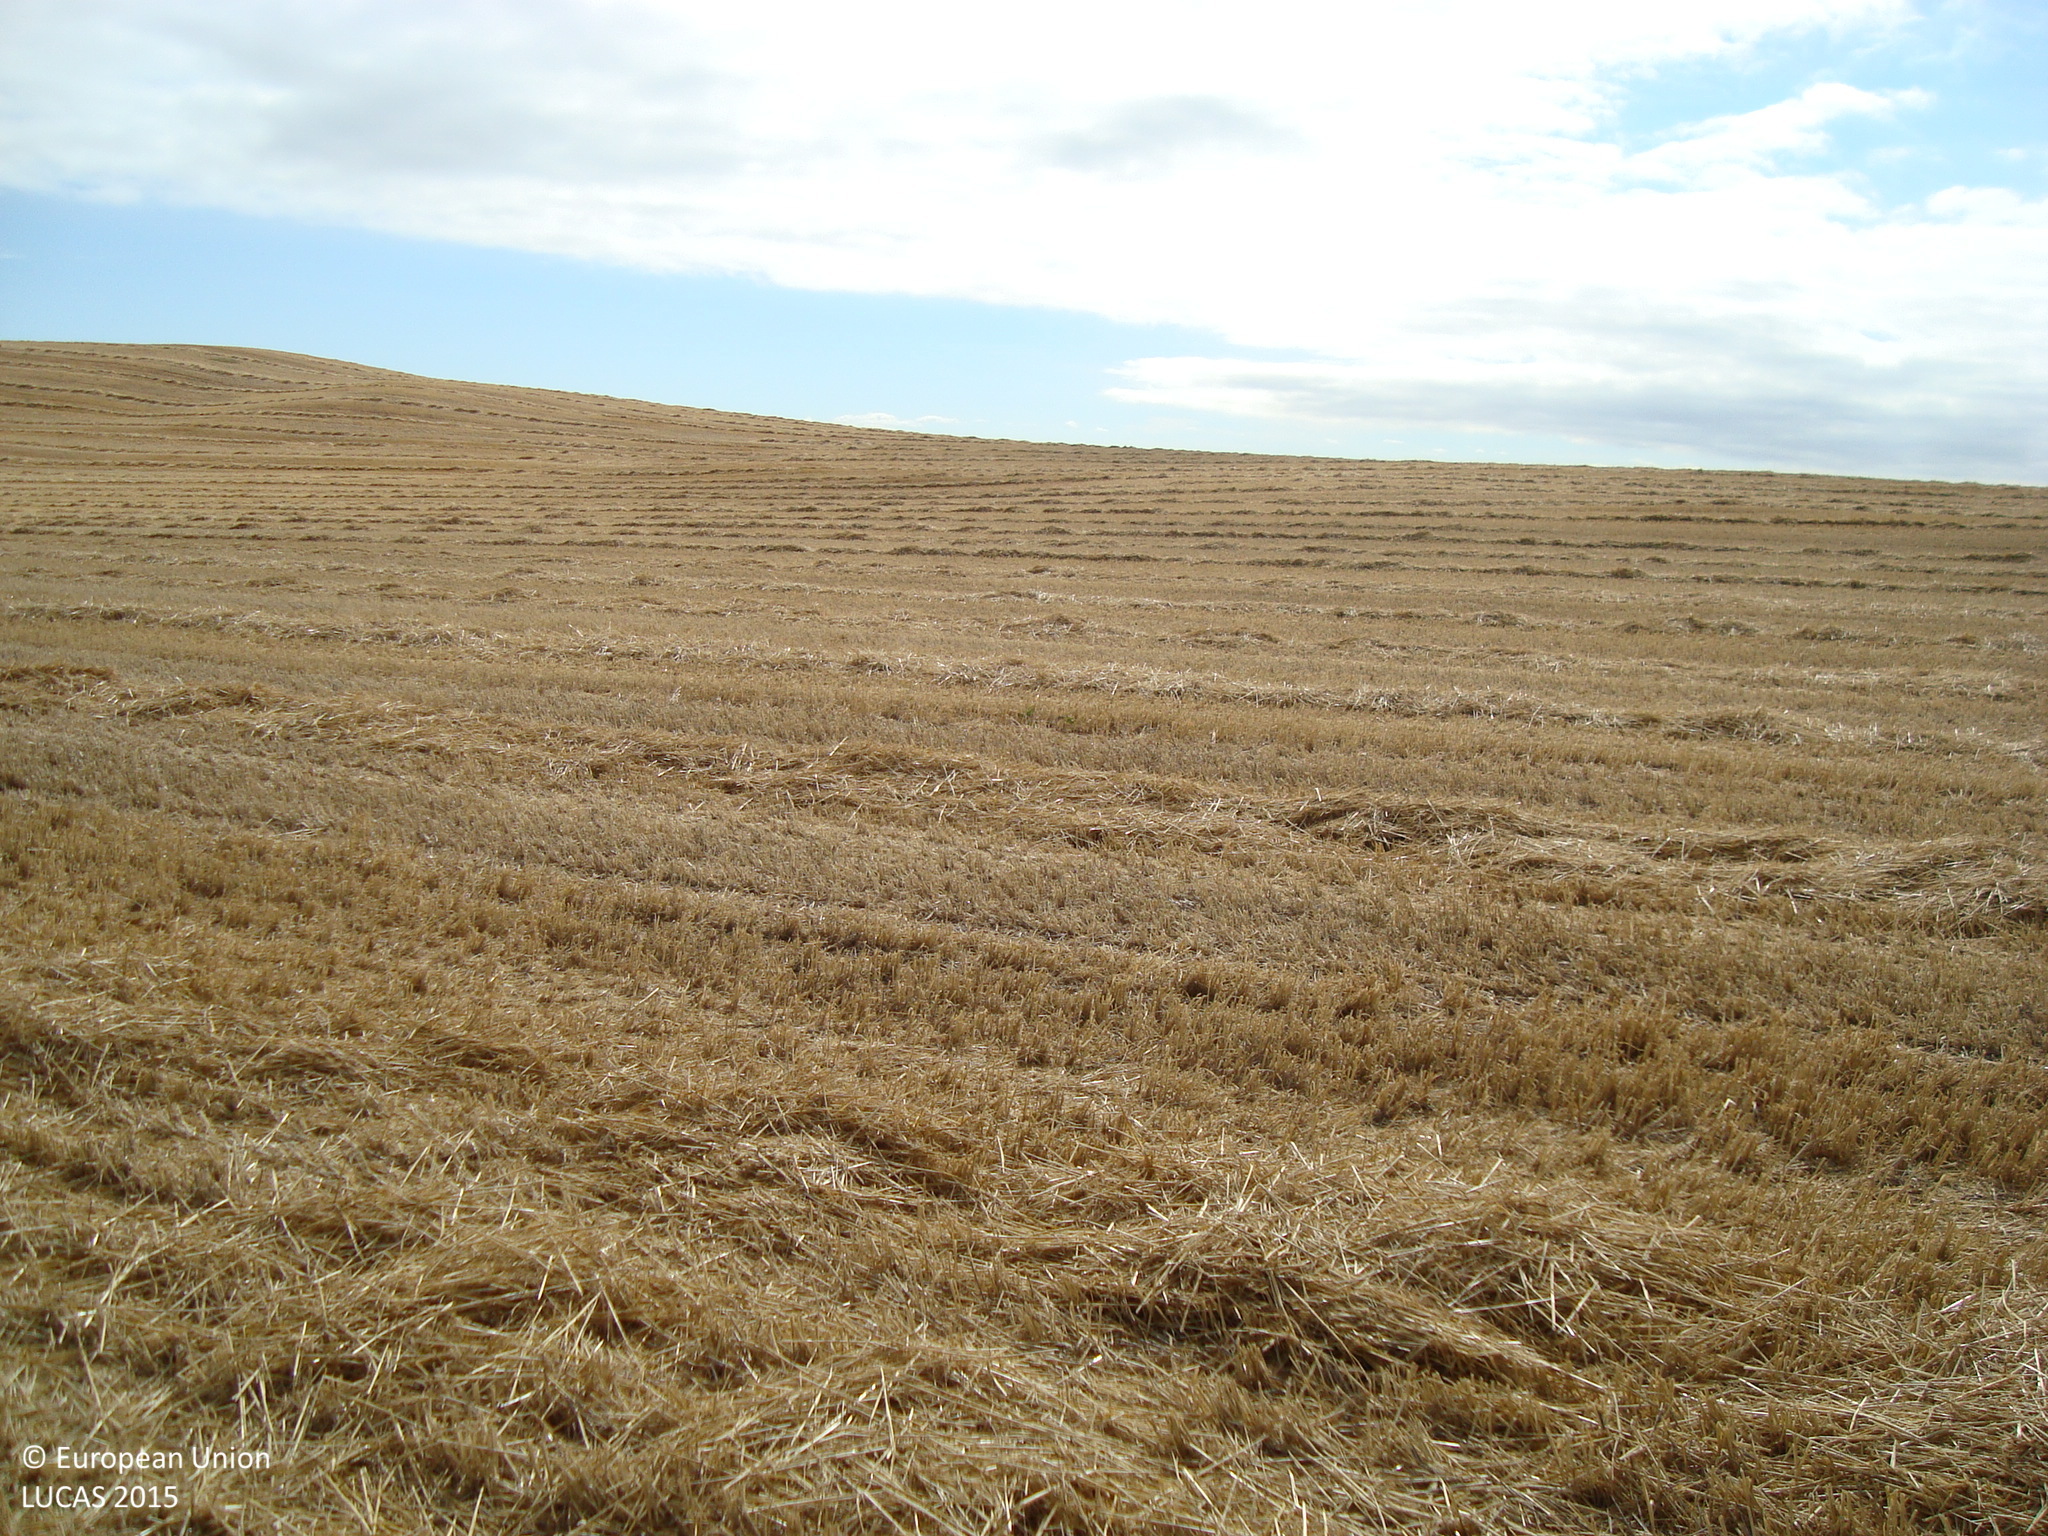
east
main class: Cropland
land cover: Common wheat
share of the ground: > 75 %
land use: Agriculture (excluding fallow land and kitchen gardens)
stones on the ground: < 10 %
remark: Harvested field
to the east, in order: Common wheat; Tracks; Common wheat
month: July
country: ES
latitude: 42.0004
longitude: -3.9074
